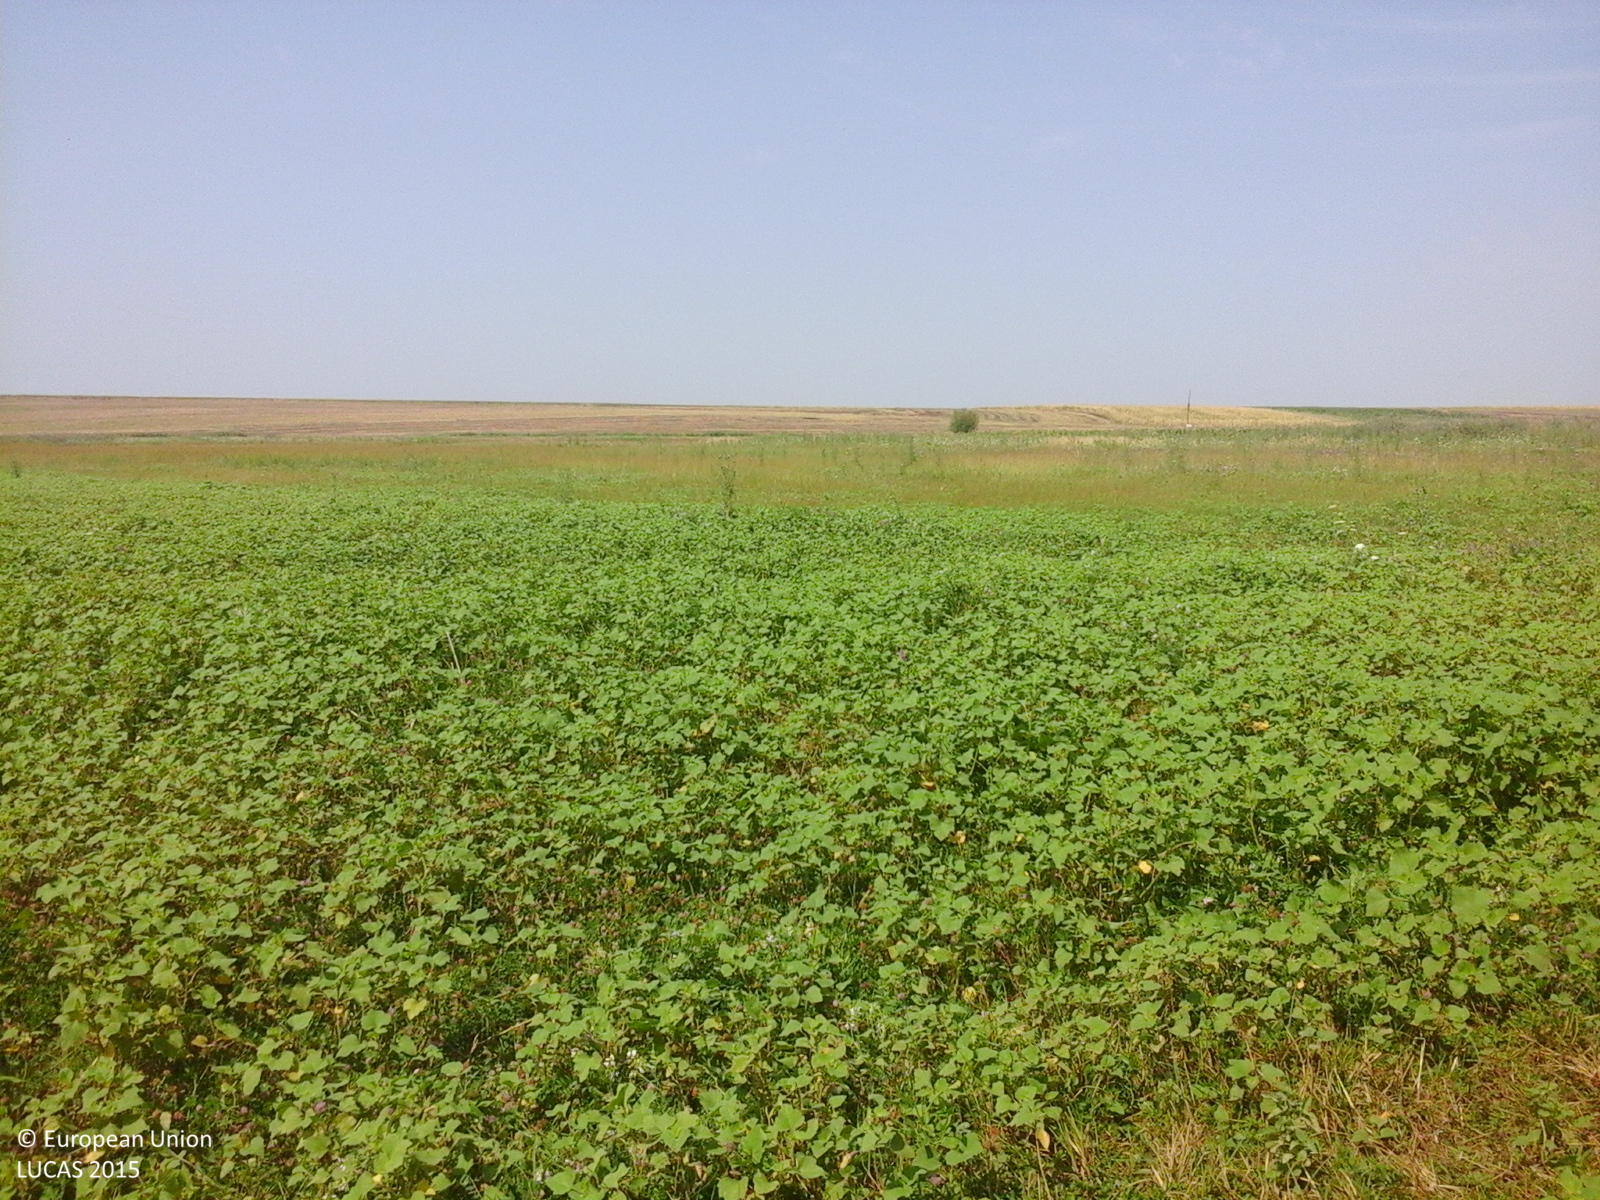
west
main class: Grassland
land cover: Spontaneously vegetated surfaces
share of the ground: > 75 %
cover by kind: herbaceous plants 100 %
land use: Agriculture (excluding fallow land and kitchen gardens)
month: August
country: RO
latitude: 44.1732
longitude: 23.2417
